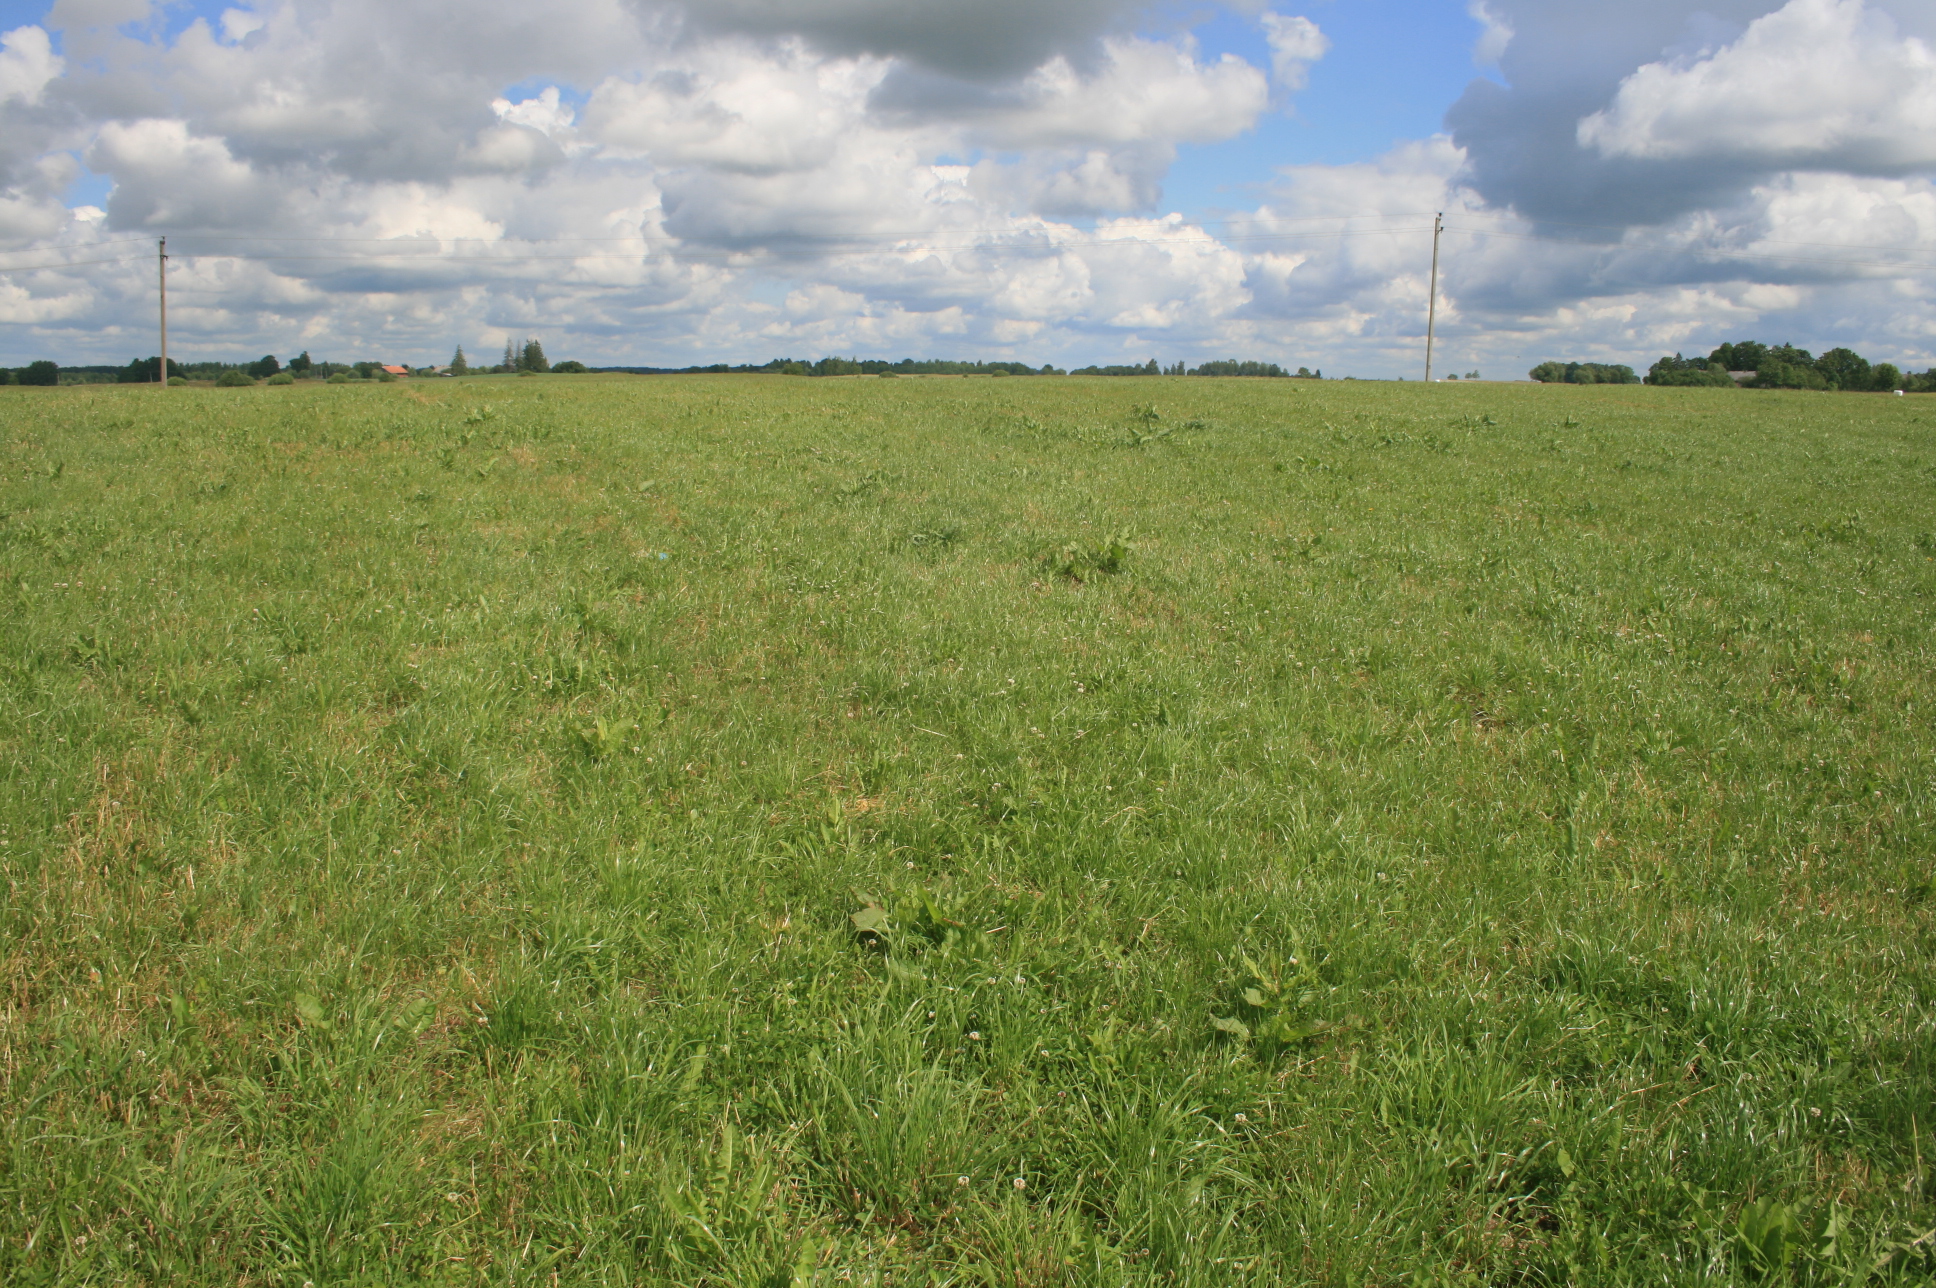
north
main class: Grassland
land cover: Grassland without tree/shrub cover
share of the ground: > 75 %
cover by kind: herbaceous plants 100 %
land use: Agriculture (excluding fallow land and kitchen gardens)
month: June
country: LT
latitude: 55.2143
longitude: 22.0786
